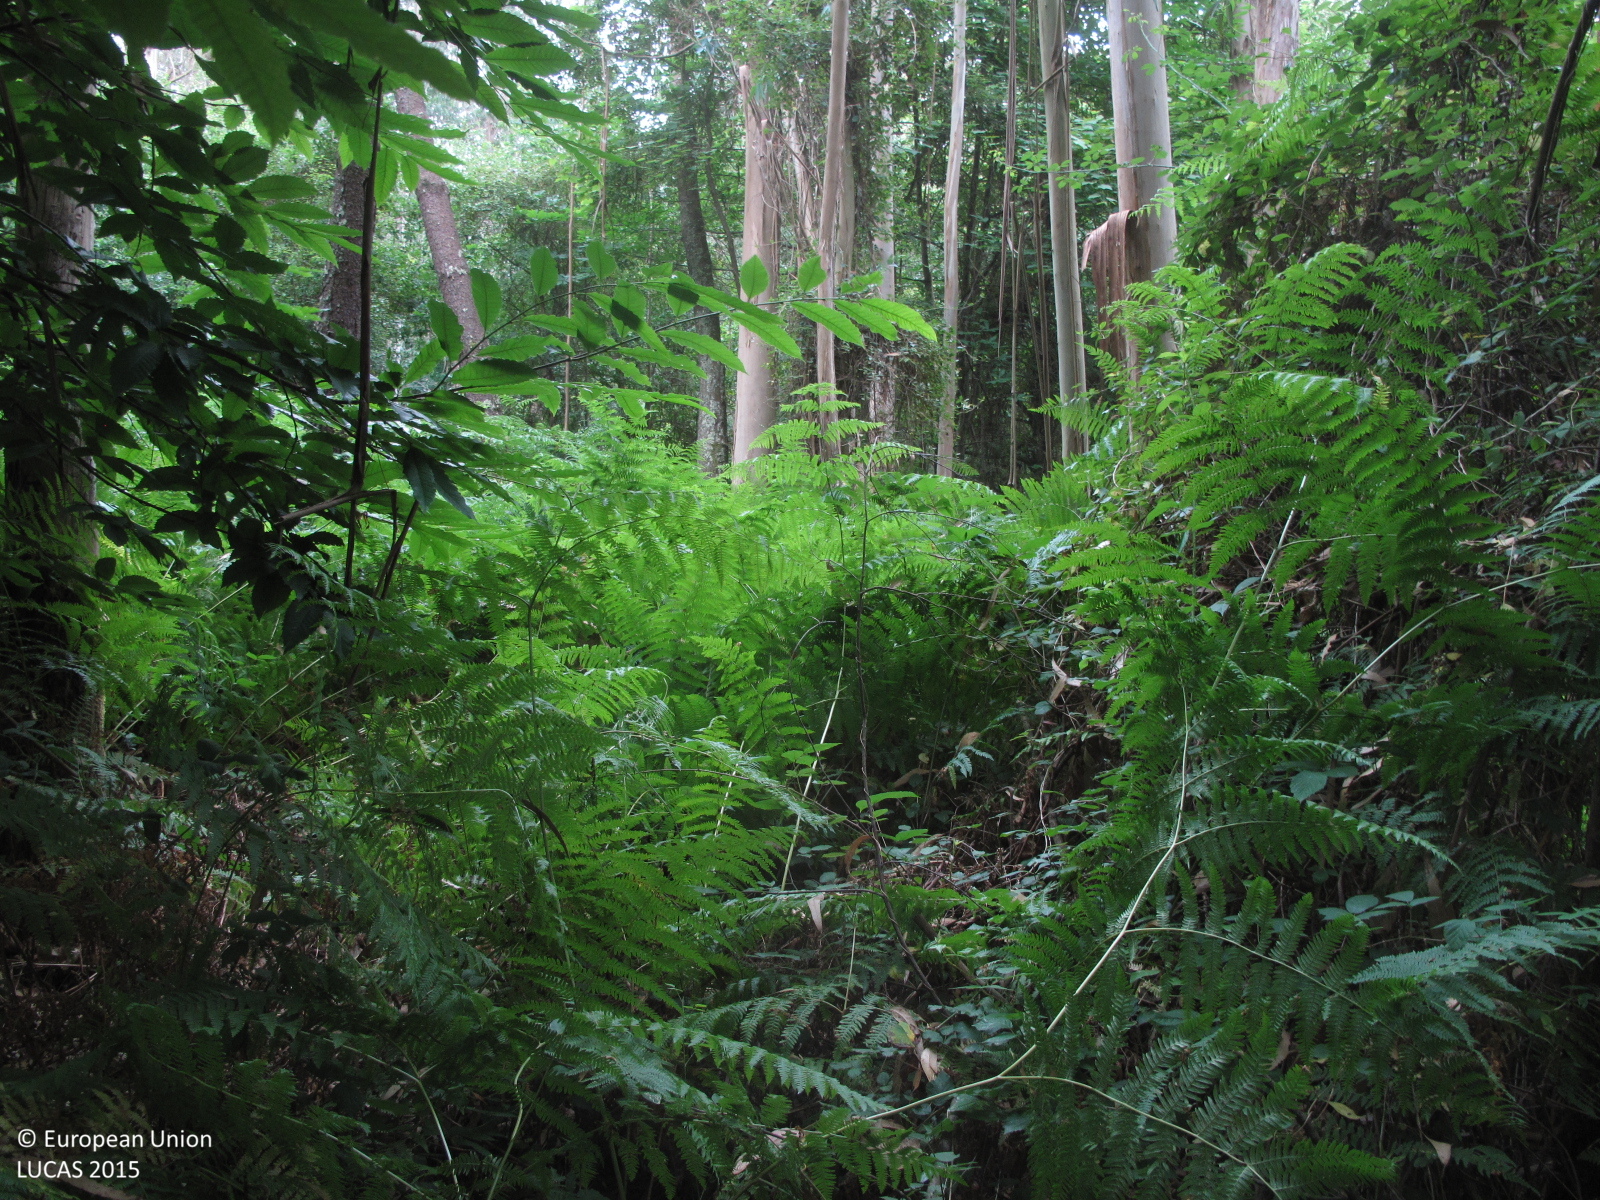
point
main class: Woodland
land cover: Broadleaved woodland
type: thermophilous deciduous forest
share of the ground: > 75 %
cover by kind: broadleaved forest trees 90 %, shrubs 5 %, herbaceous plants 5 %
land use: Forestry
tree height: > 5 m
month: July
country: ES
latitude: 43.3737
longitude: -8.1807
